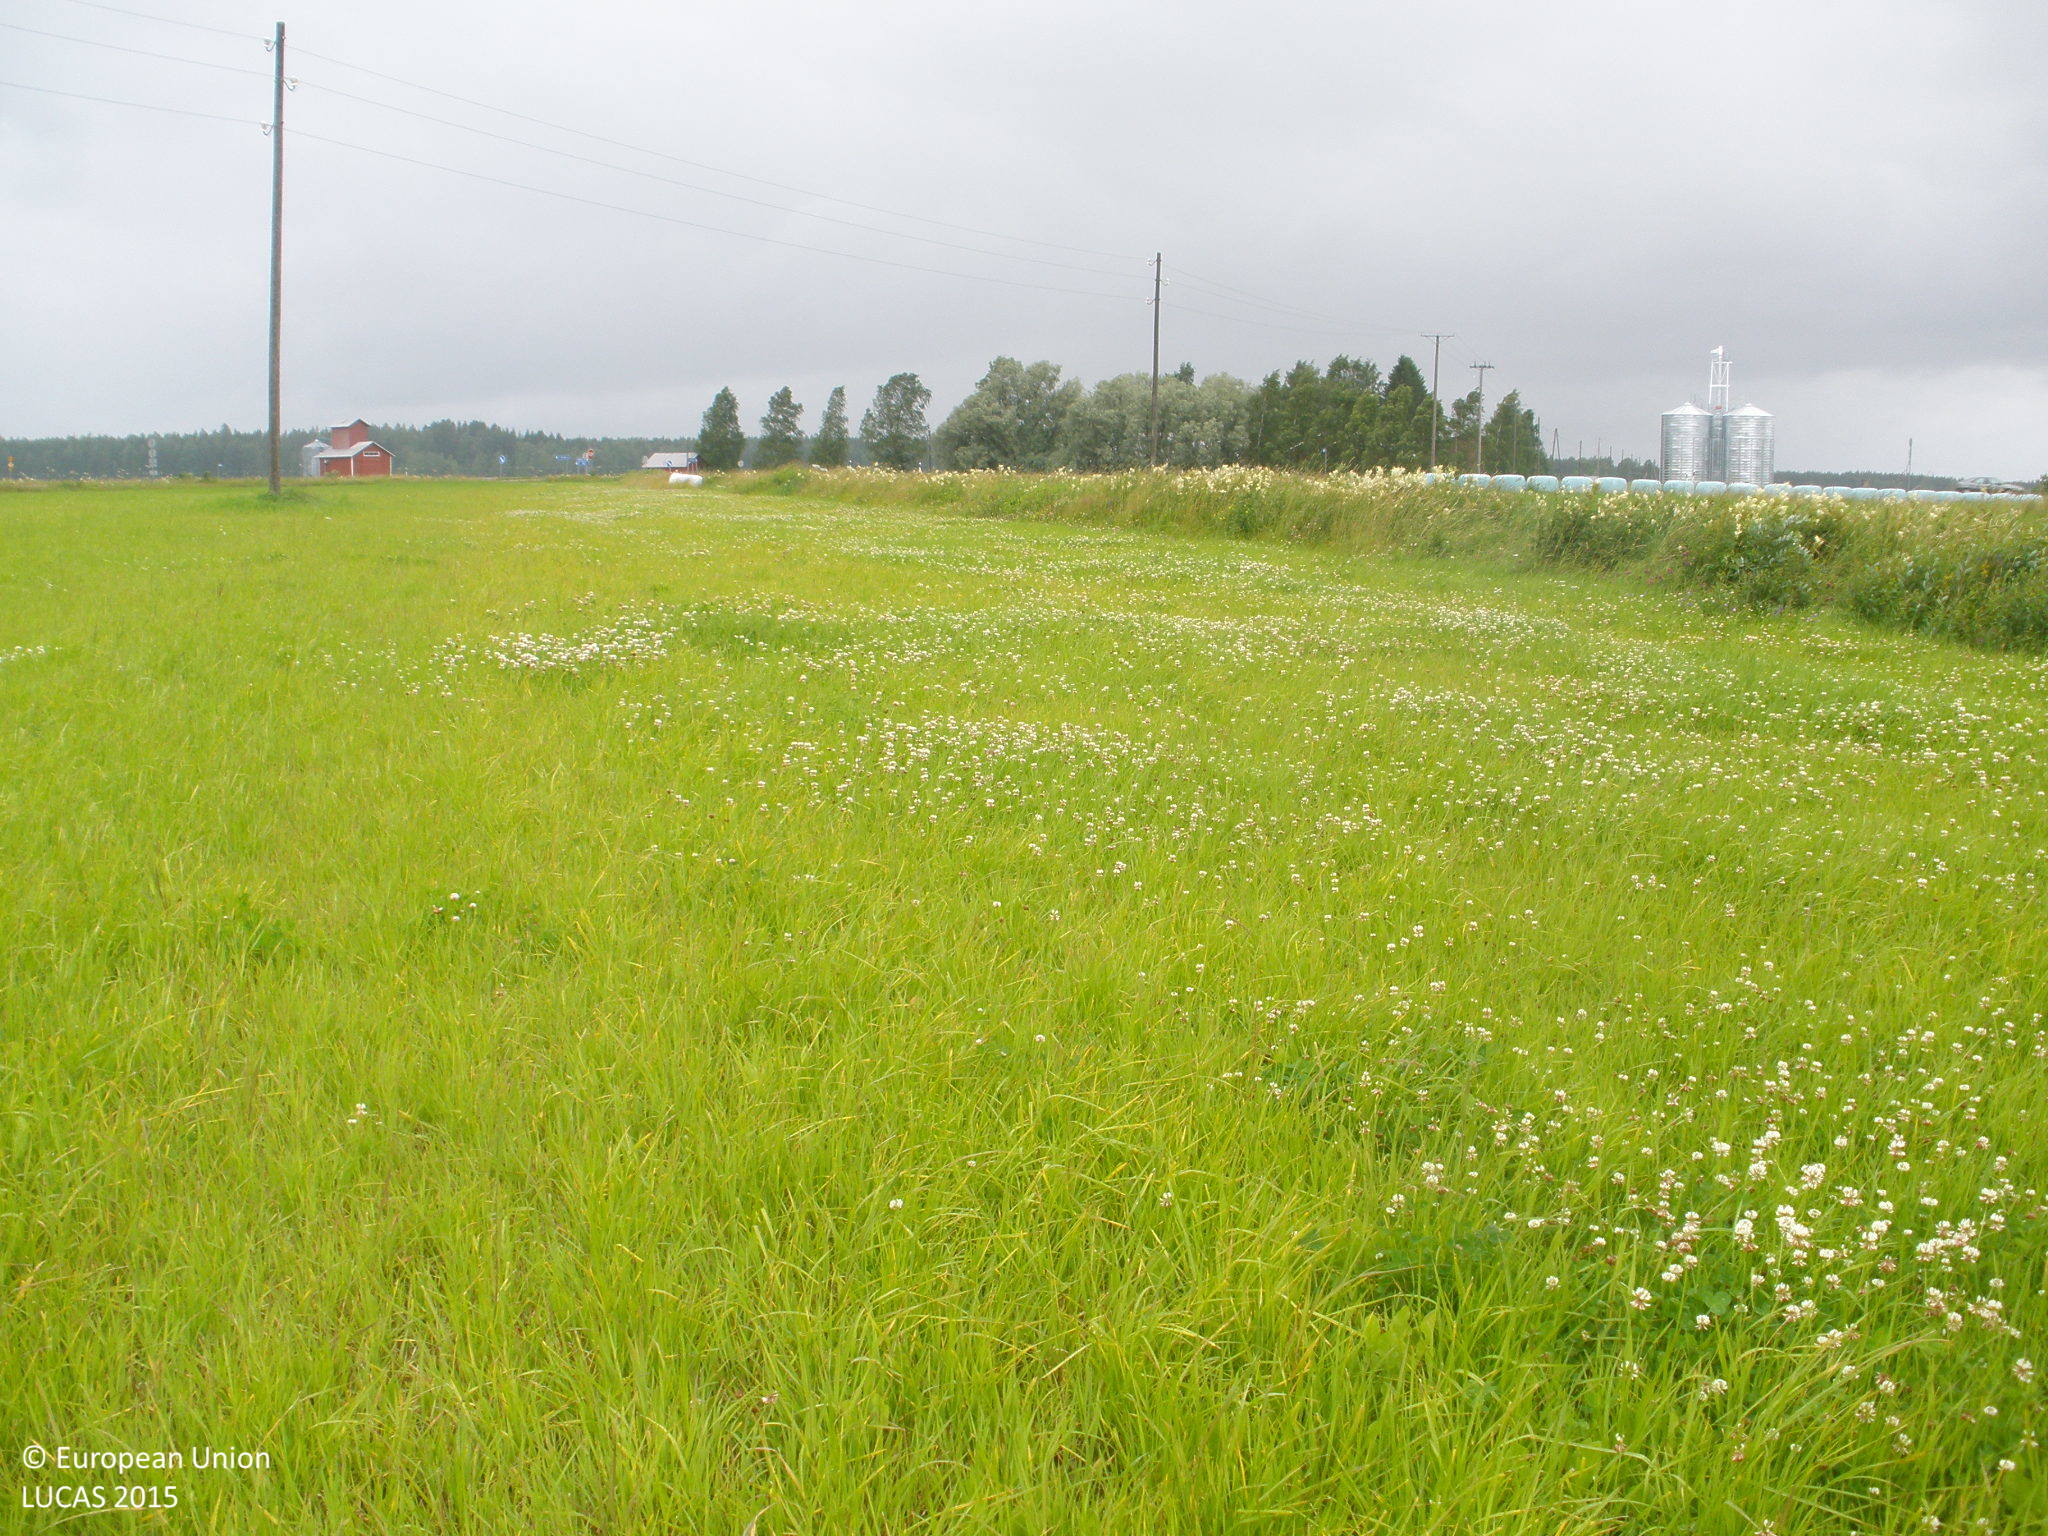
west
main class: Cropland
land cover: Temporary grasslands
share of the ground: > 75 %
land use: Agriculture (excluding fallow land and kitchen gardens)
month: July
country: FI
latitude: 60.5464
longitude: 23.3750
